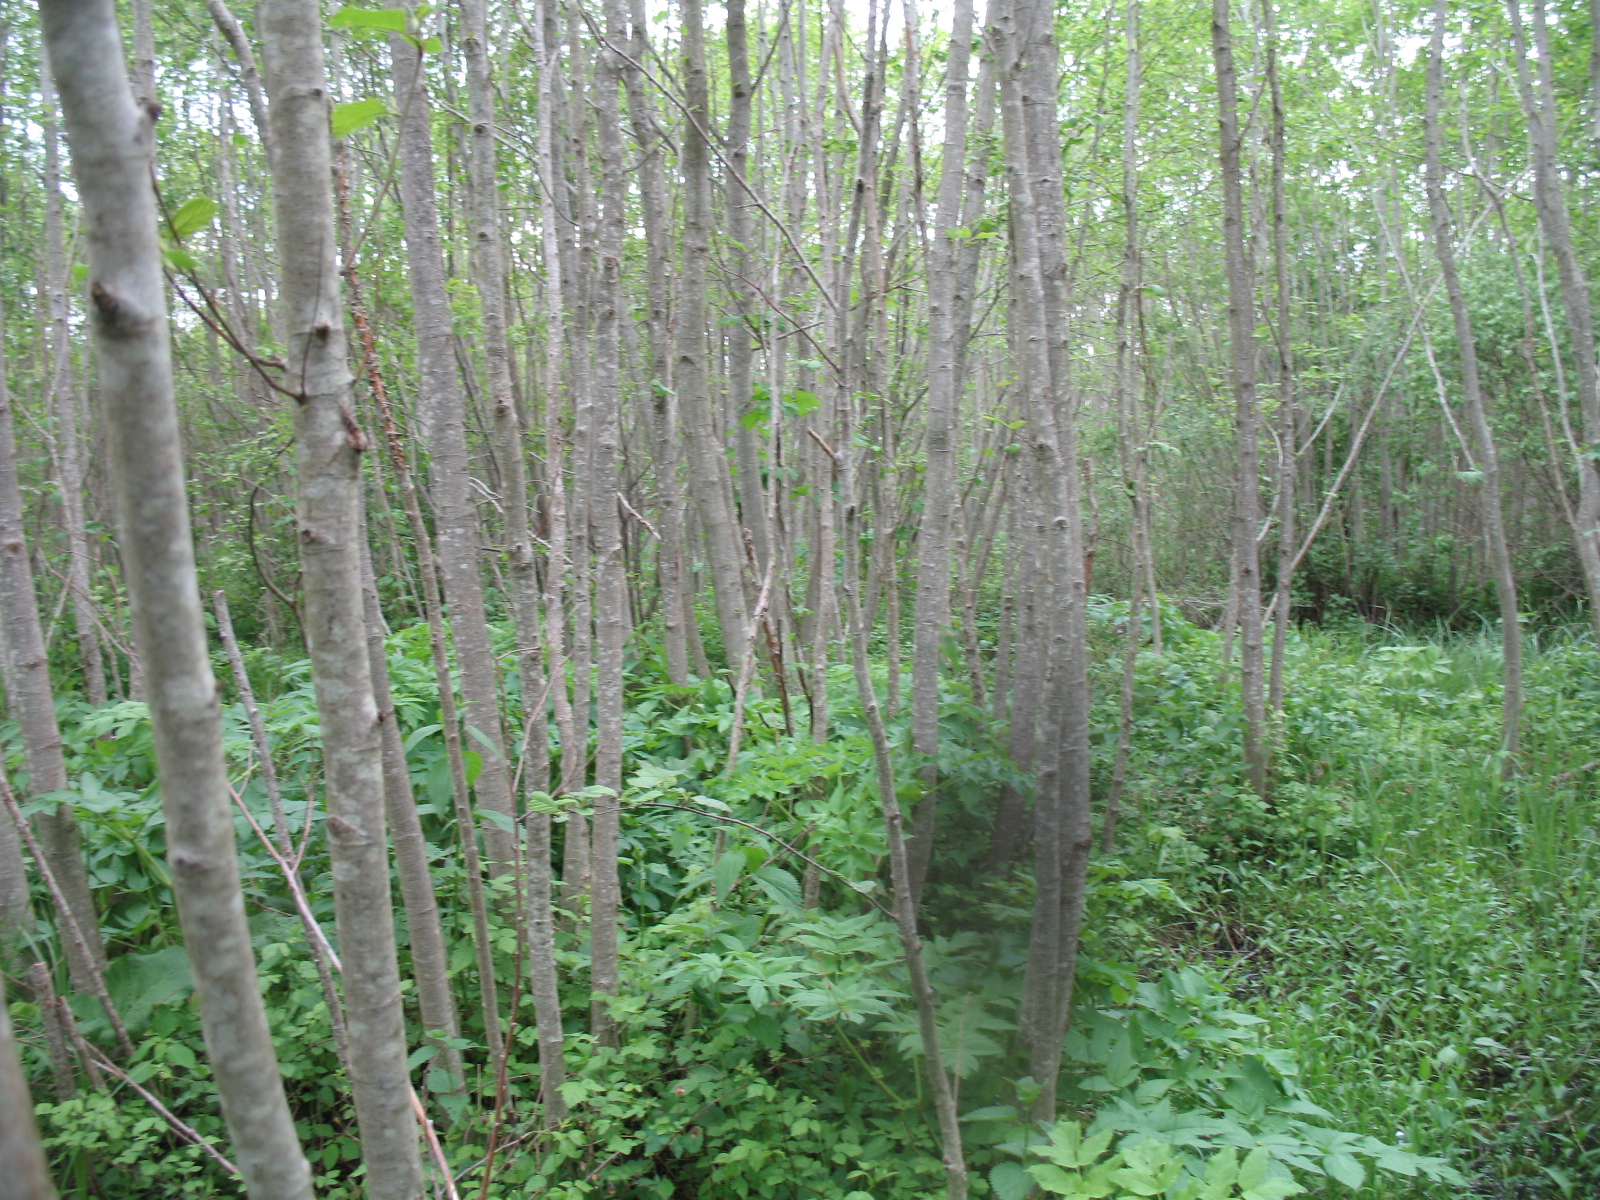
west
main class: Woodland
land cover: Broadleaved woodland
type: mire and swamp forests
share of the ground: > 75 %
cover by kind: broadleaved forest trees 95 %, herbaceous plants 5 %
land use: Forestry
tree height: > 5 m
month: May
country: LV
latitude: 56.7451
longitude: 23.5315
